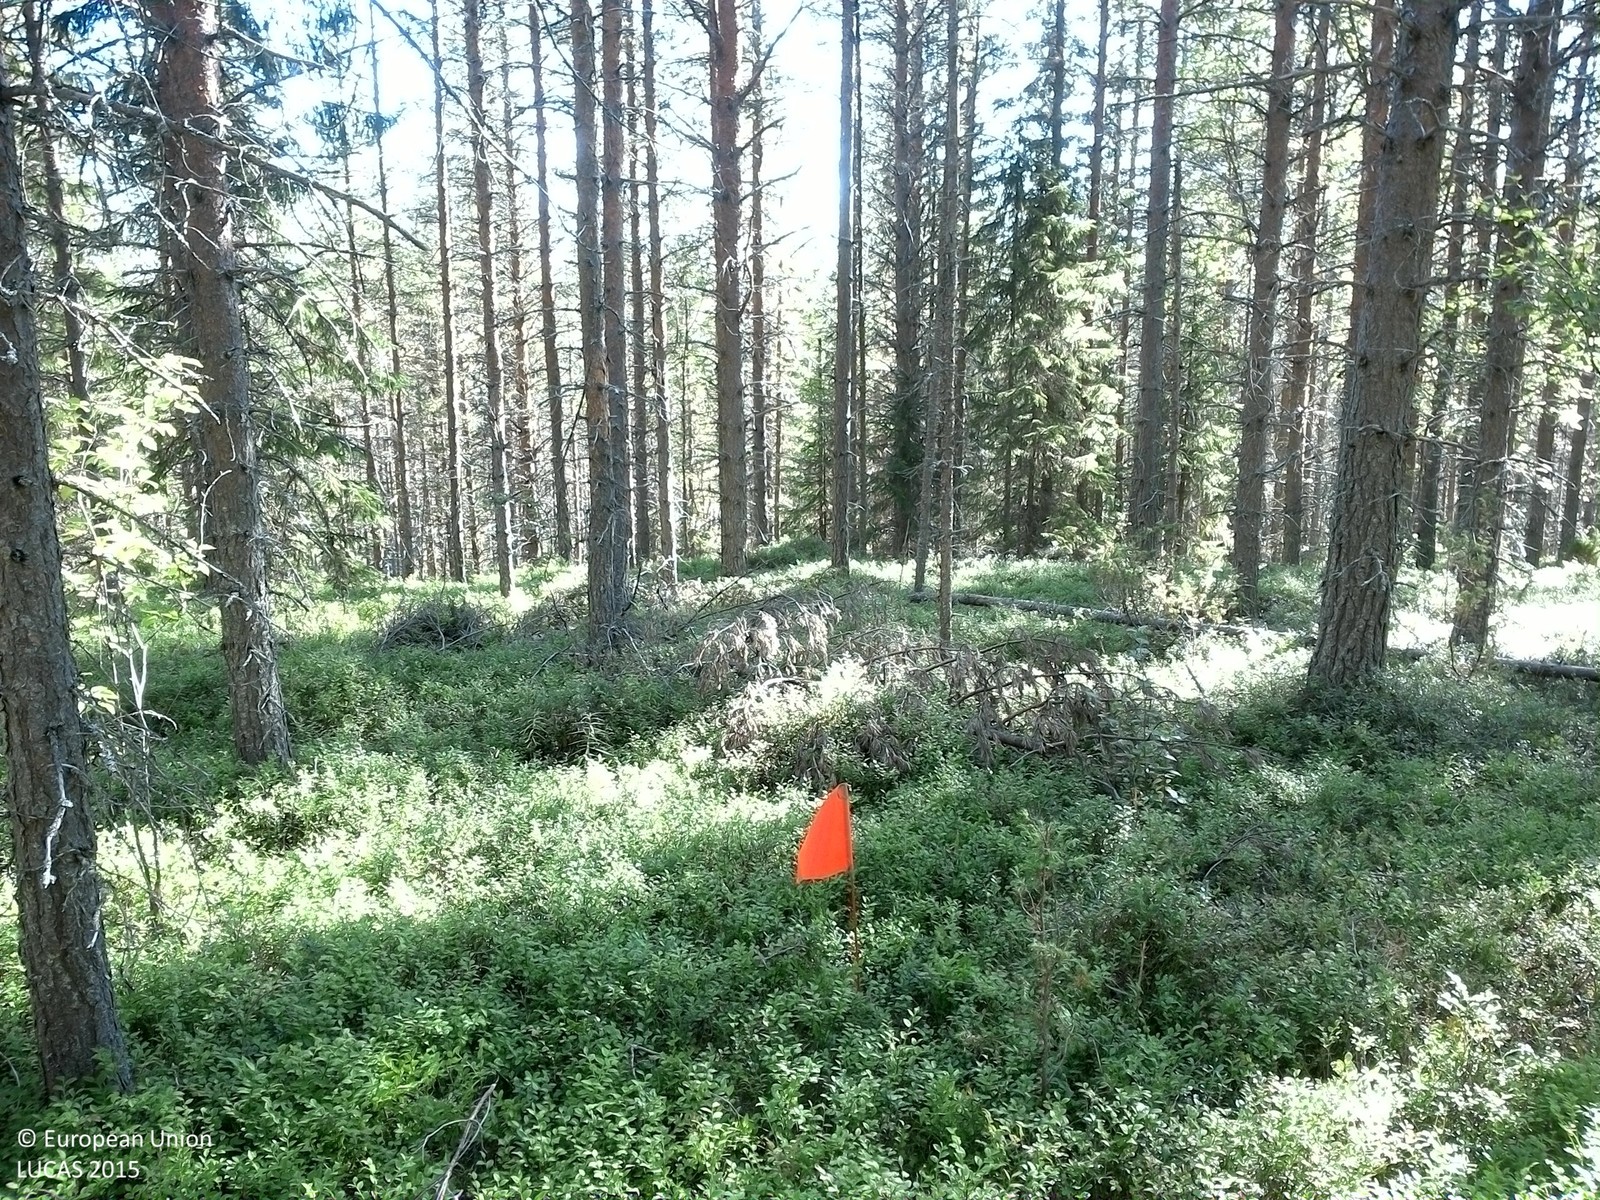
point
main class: Woodland
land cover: Pine dominated coniferous woodland
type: boreal forest
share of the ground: > 75 %
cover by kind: coniferous forest trees 75 %, shrubs 25 %
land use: Forestry
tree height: > 5 m
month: August
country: SE
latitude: 63.6601
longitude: 17.8315
